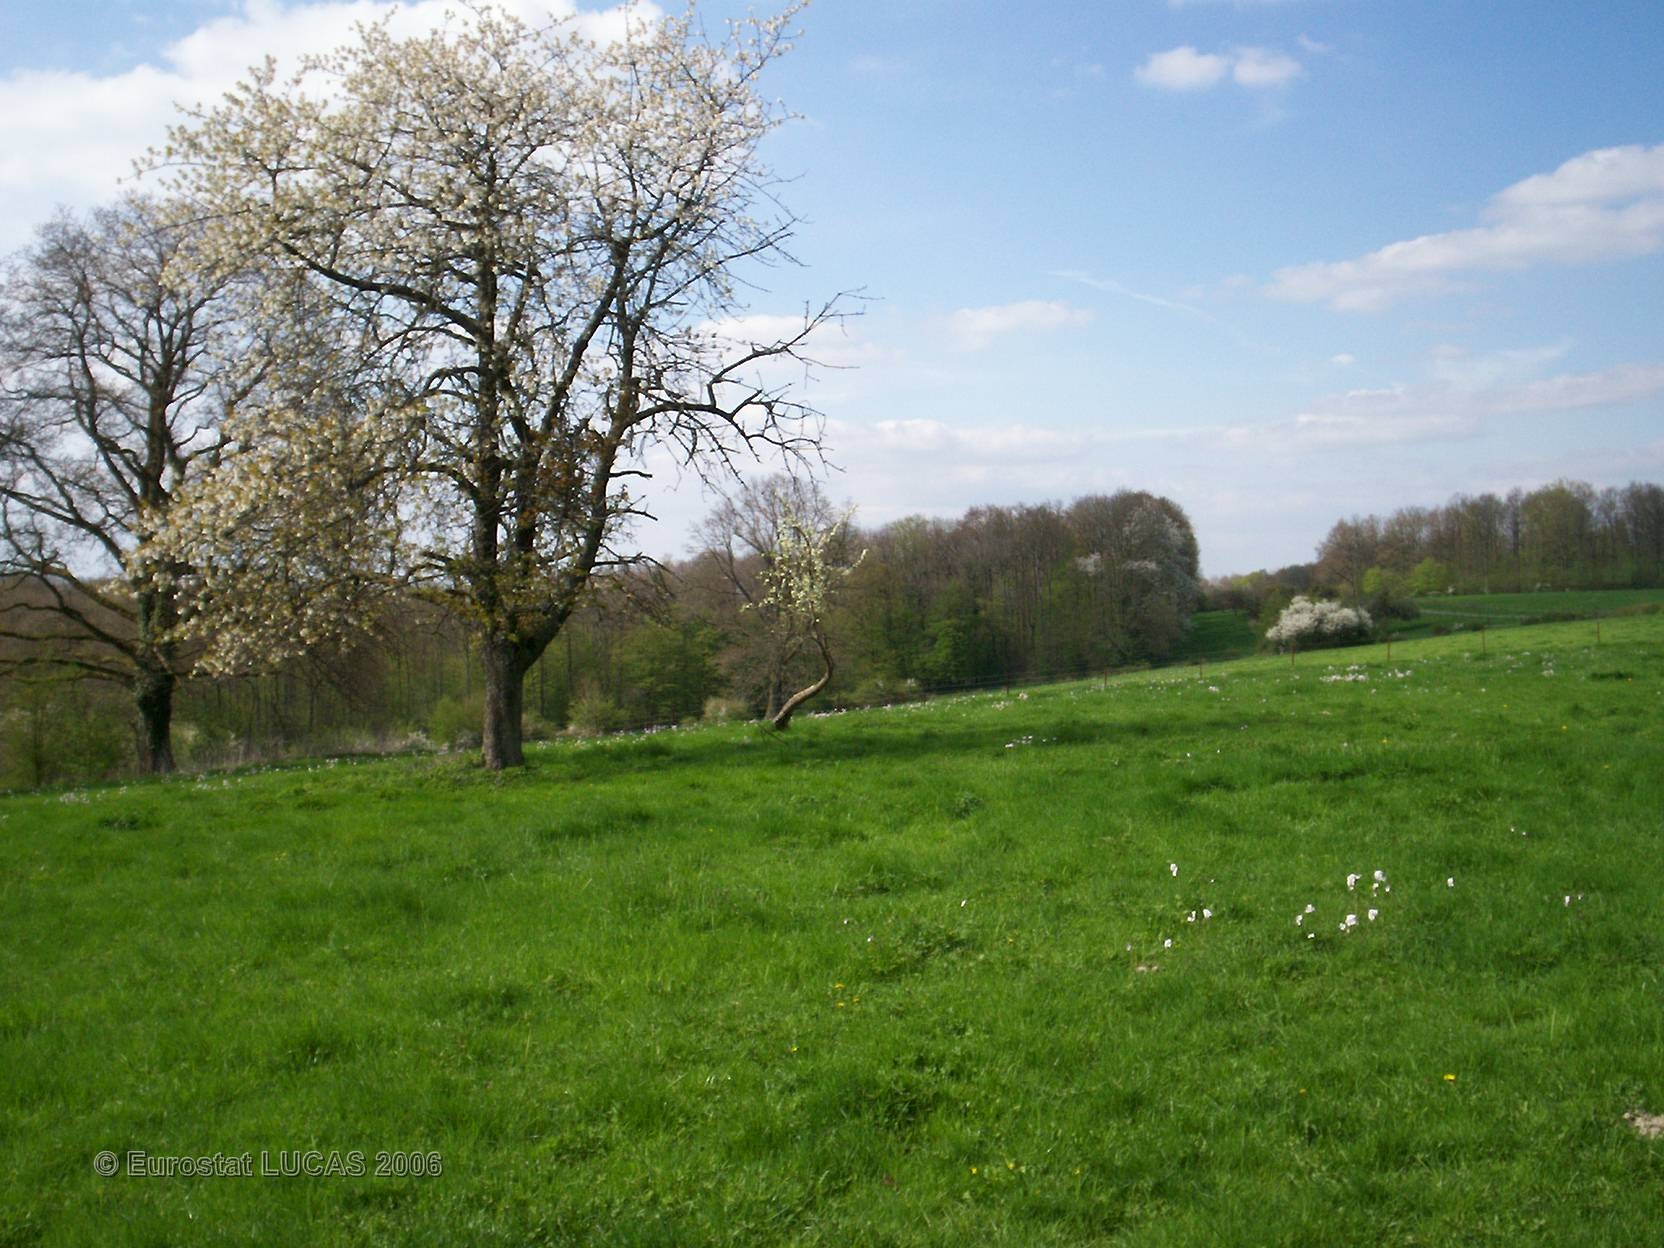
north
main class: Grassland
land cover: Grassland without tree/shrub cover
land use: Agriculture (excluding fallow land and kitchen gardens)
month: April
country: FR
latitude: 49.7721
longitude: 4.3164
